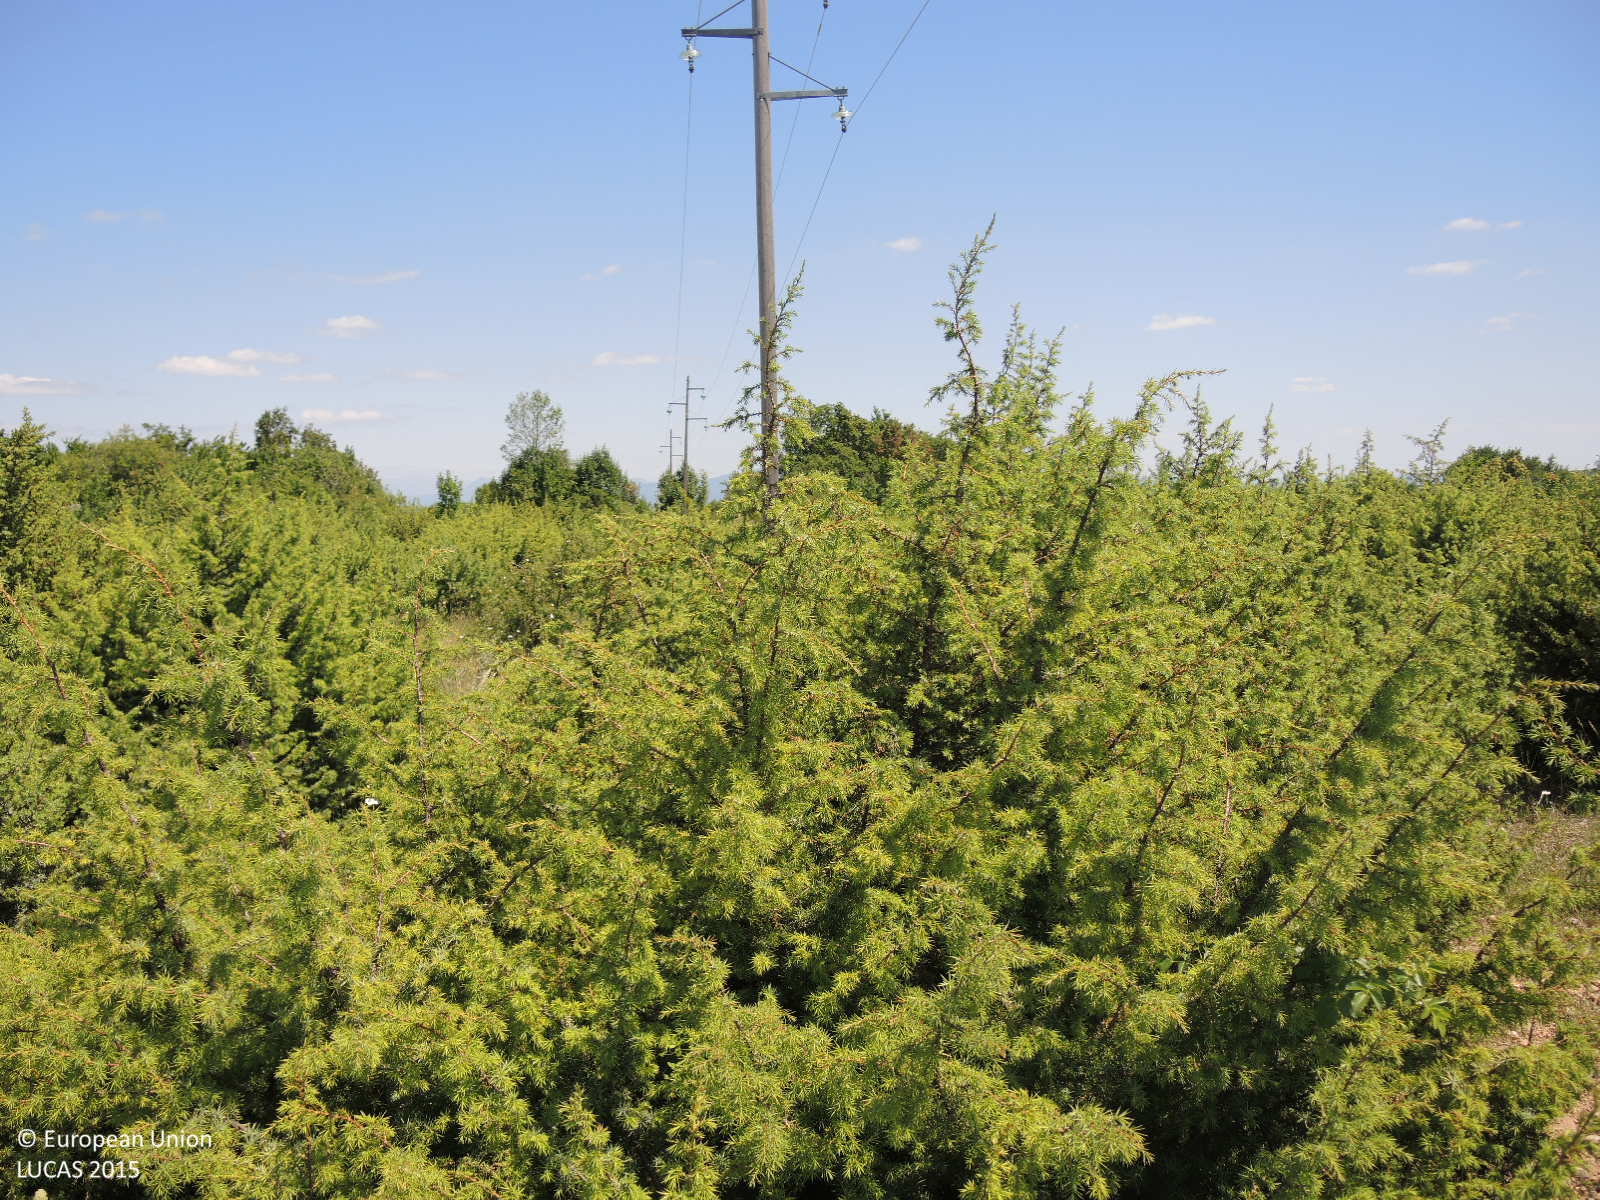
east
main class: Shrubland
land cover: Shrubland without tree cover
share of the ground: 25 - 50 %
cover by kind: shrubs 45 %, herbaceous plants 35 %, unconsolidated bare surface 20 %
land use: Semi-natural and natural areas not in use
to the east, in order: Shrubland without tree cover; Electric lines; Shrubland without tree cover; Grass margins; Paved roads, cycling and walking lanes; Grass margins; Dry stone walls; Shrubland without tree cover; Dry stone walls; Shrubland without tree cover; Dry stone walls; Shrubland without tree cover; Dry stone walls; Shrubland with sparse tree cover; Dry stone walls; Shrubland with sparse tree cover
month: May
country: HR
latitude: 44.0425
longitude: 15.8201
